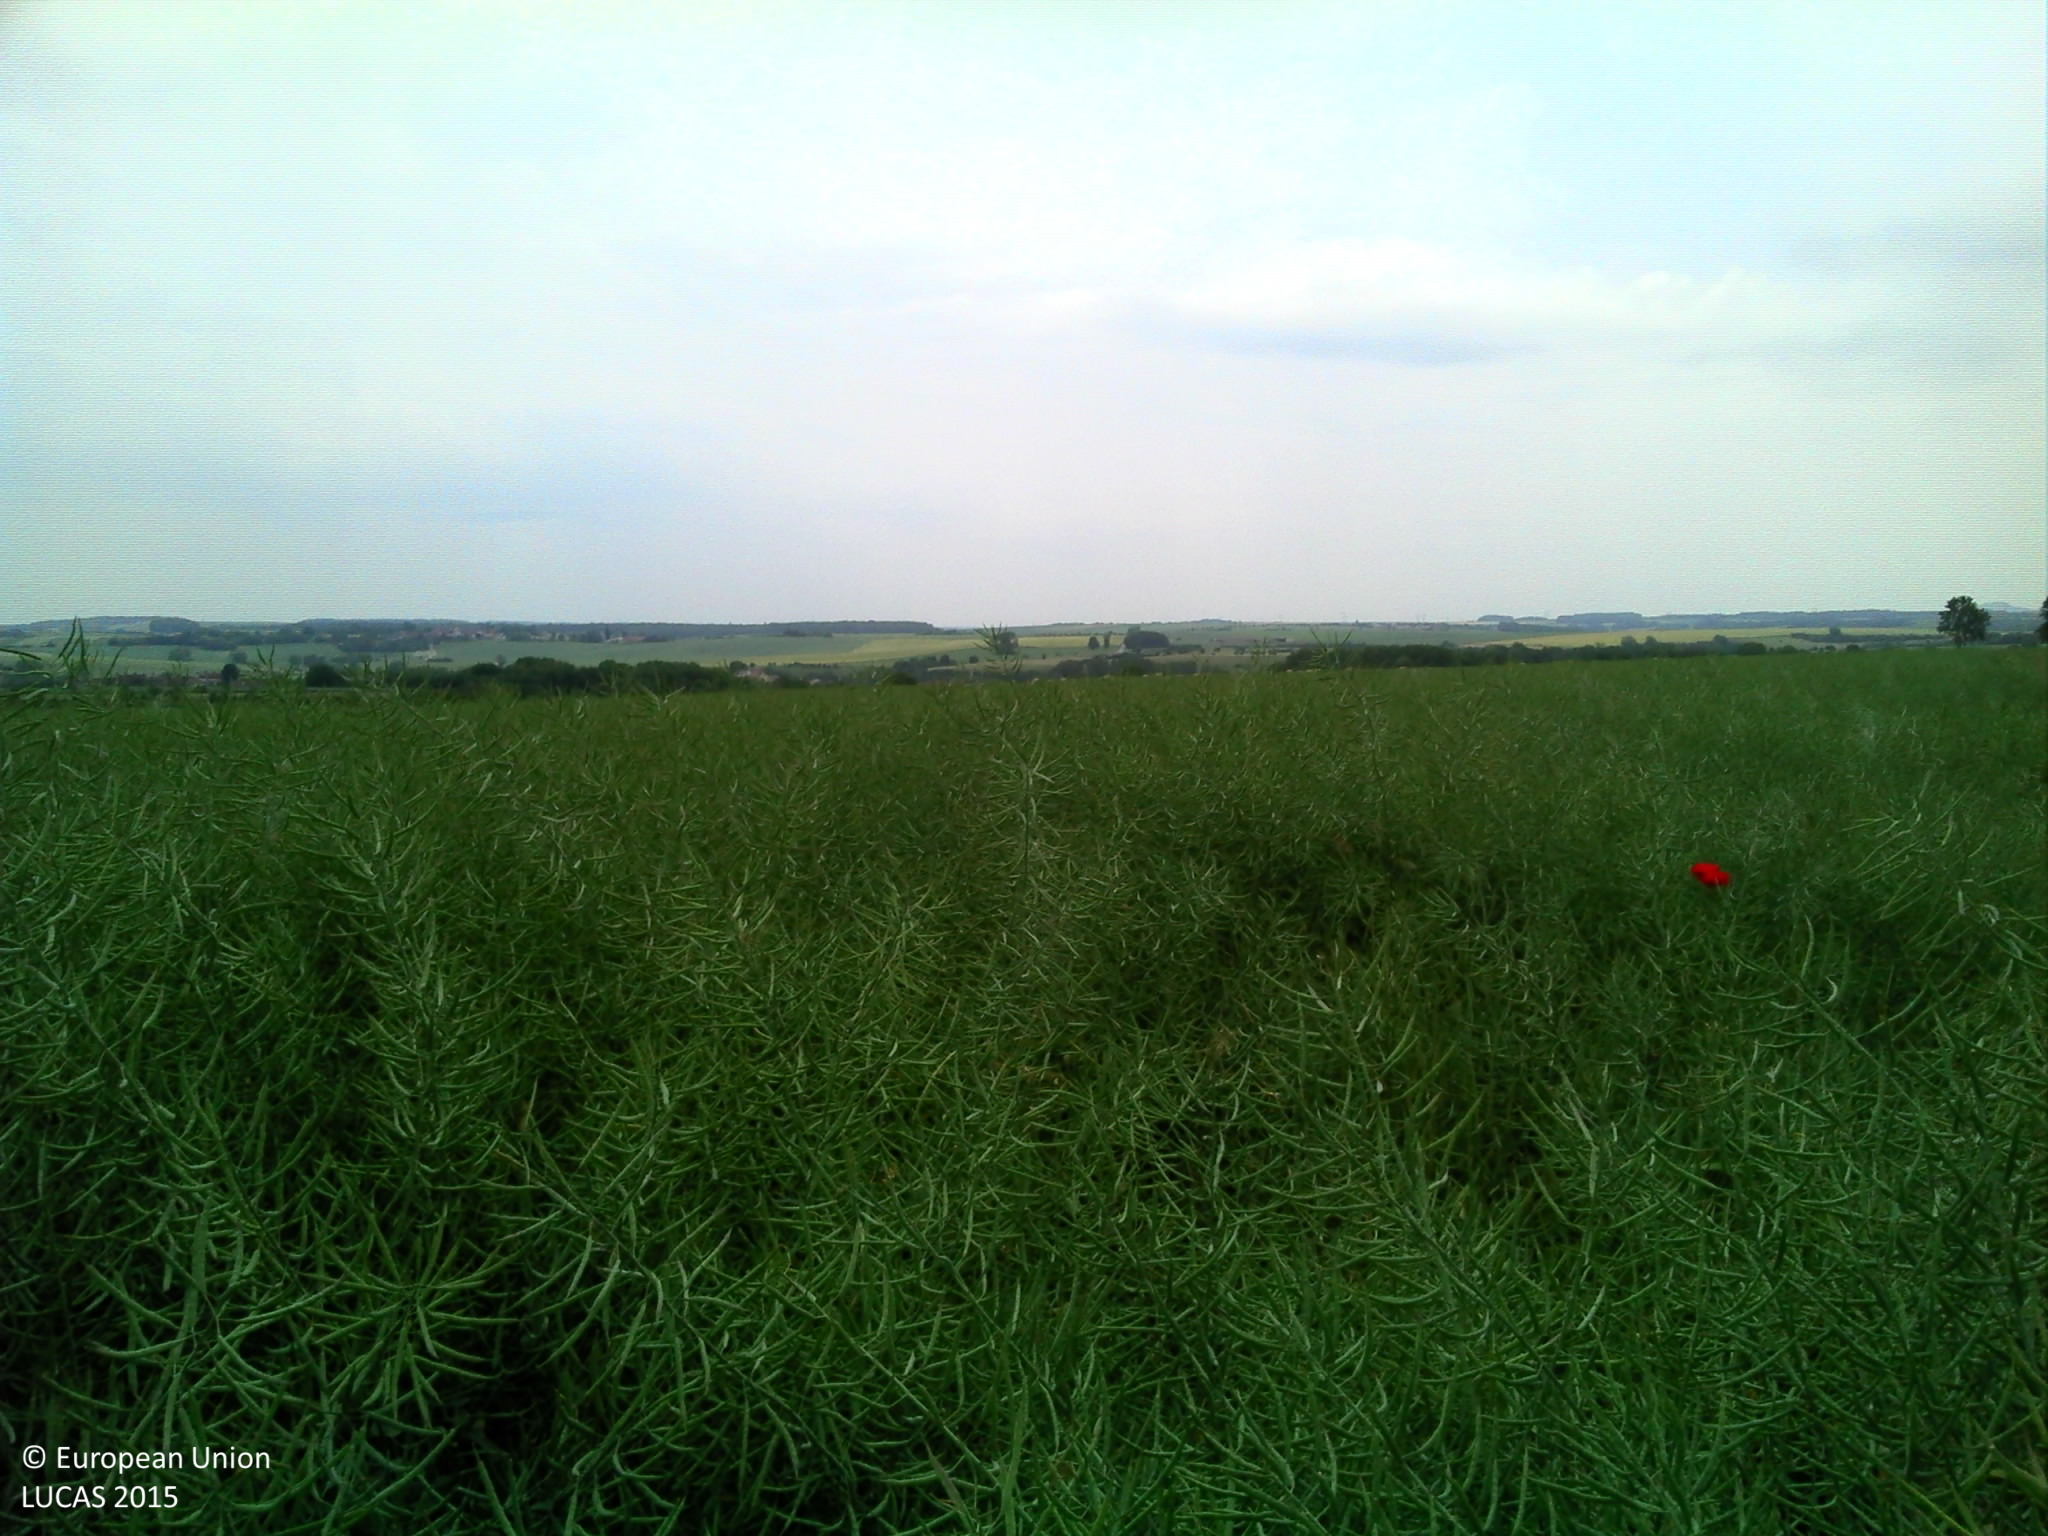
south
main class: Cropland
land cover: Rape and turnip rape
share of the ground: > 75 %
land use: Agriculture (excluding fallow land and kitchen gardens)
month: June
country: FR
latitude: 48.5182
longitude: 6.1958
